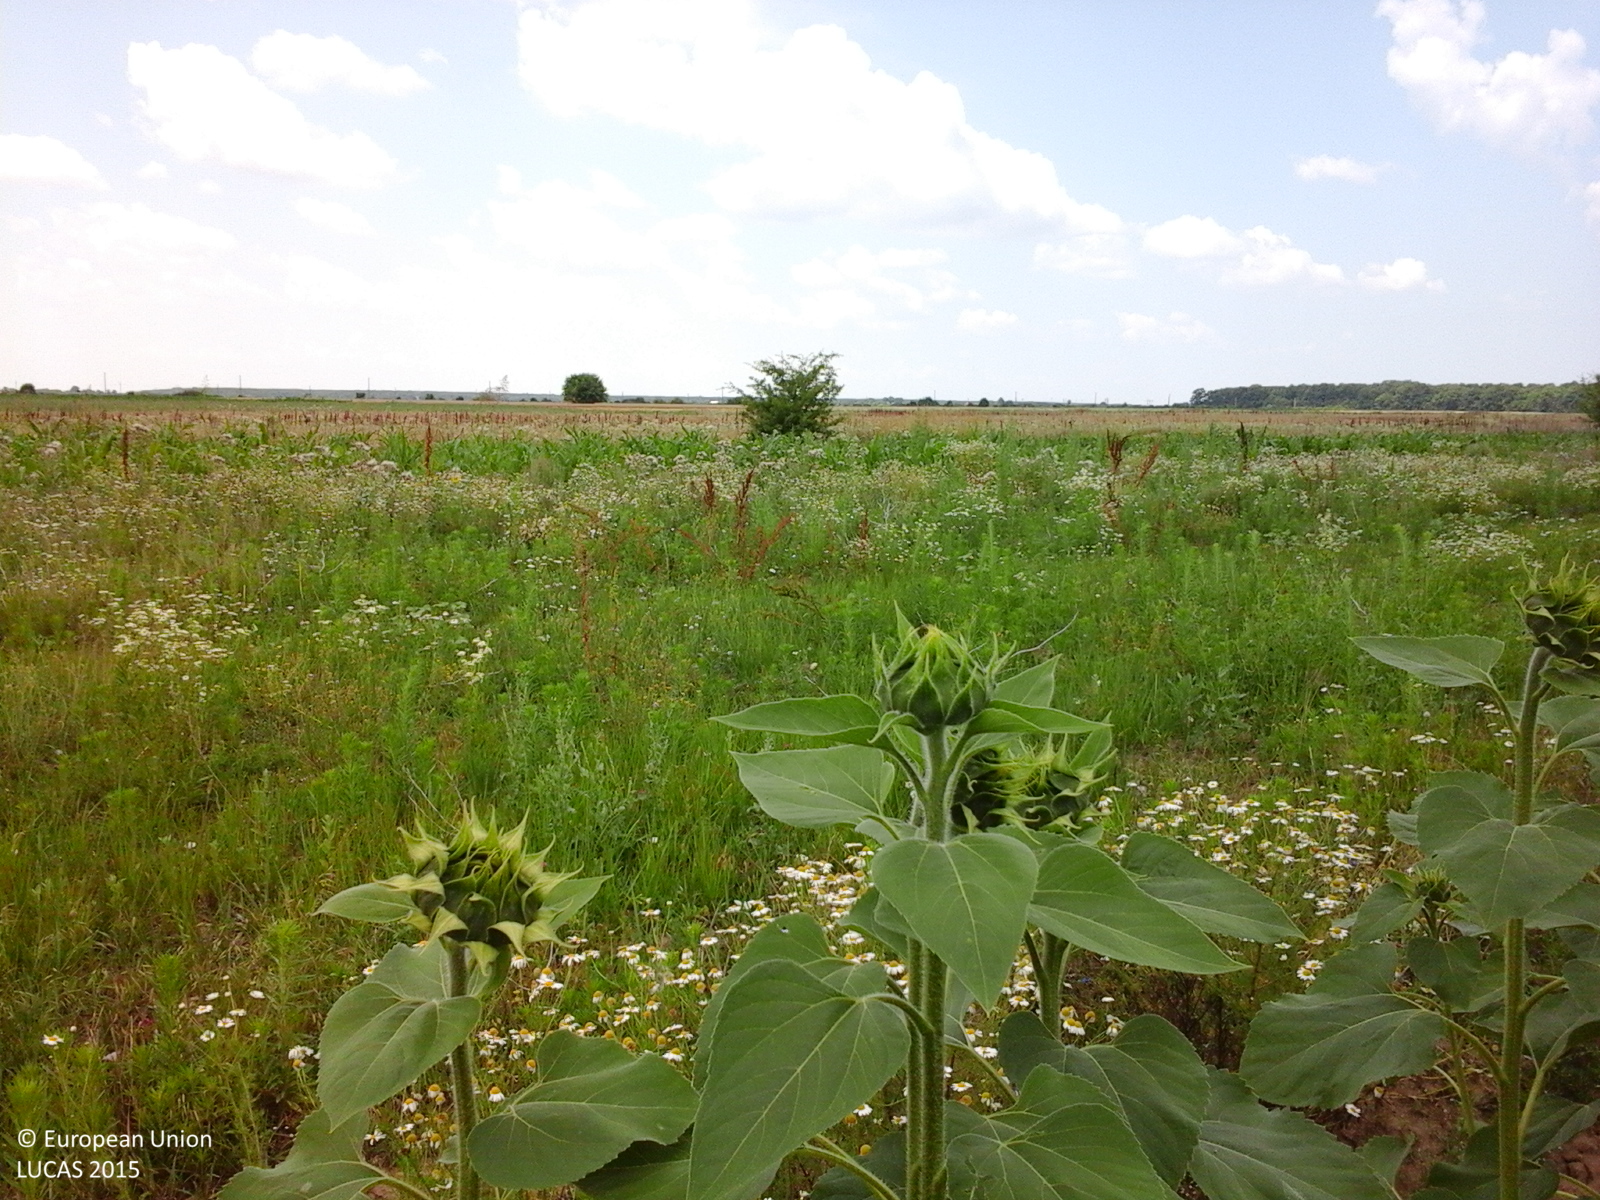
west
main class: Grassland
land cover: Spontaneously vegetated surfaces
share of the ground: > 75 %
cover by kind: herbaceous plants 100 %
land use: Fallow land
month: July
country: RO
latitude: 44.4618
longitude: 25.6165
